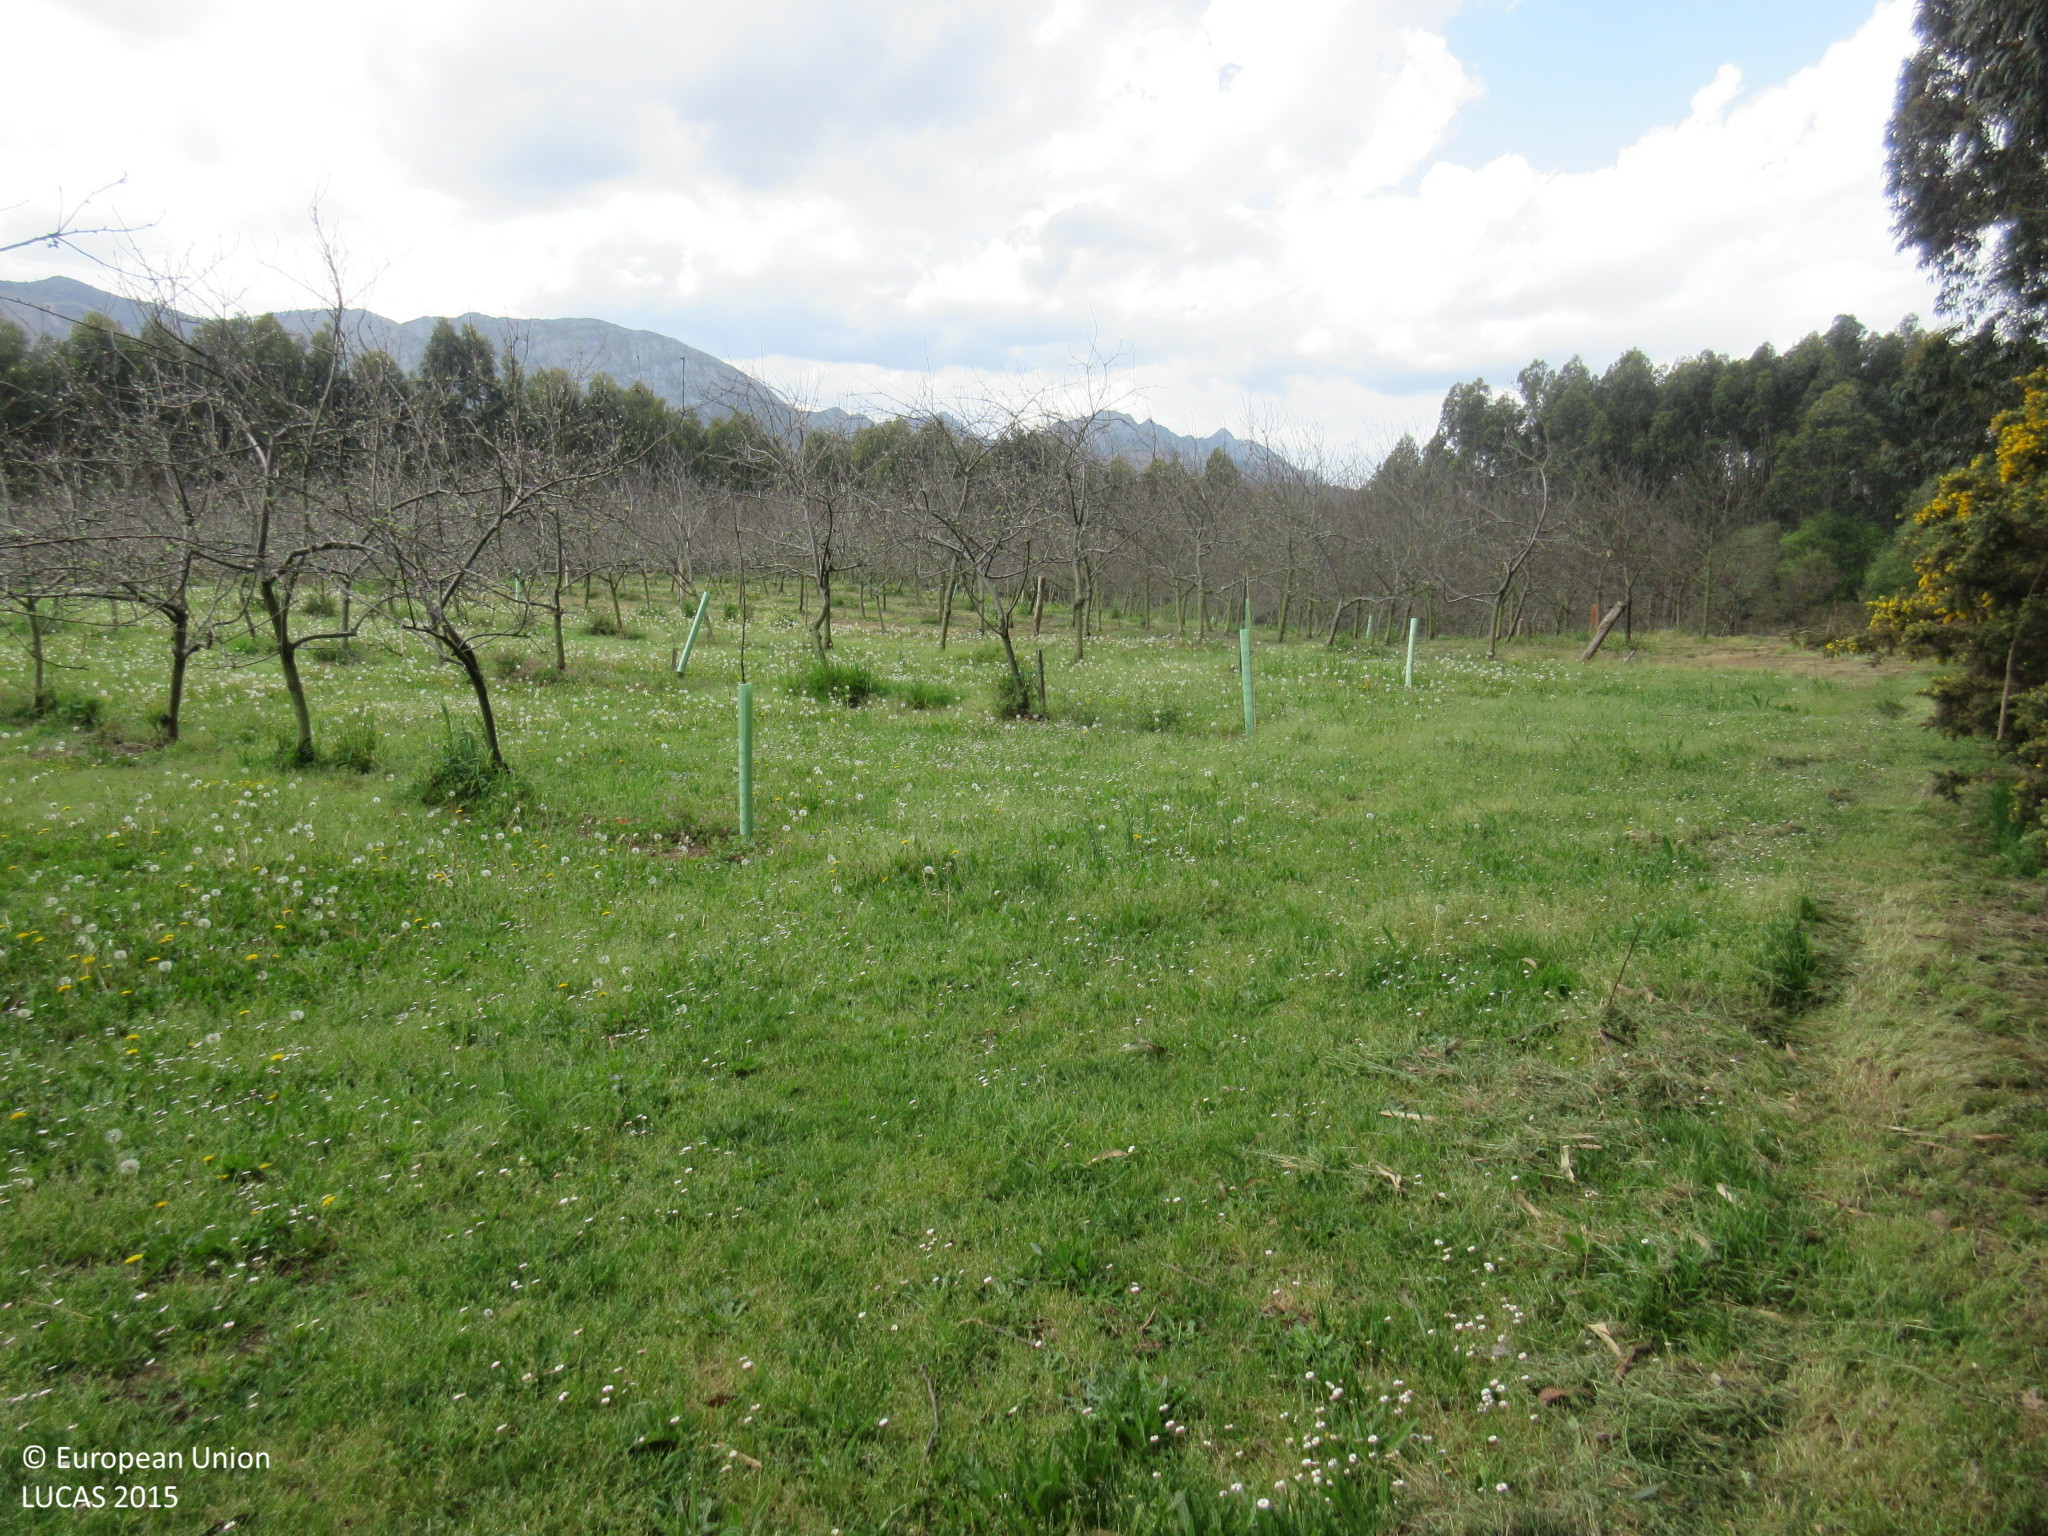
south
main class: Woodland
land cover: Broadleaved woodland
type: exotic forest
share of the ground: > 75 %
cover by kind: broadleaved forest trees 90 %, shrubs 10 %
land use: Forestry
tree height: > 5 m
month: April
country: ES
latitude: 43.4736
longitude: -5.1180
